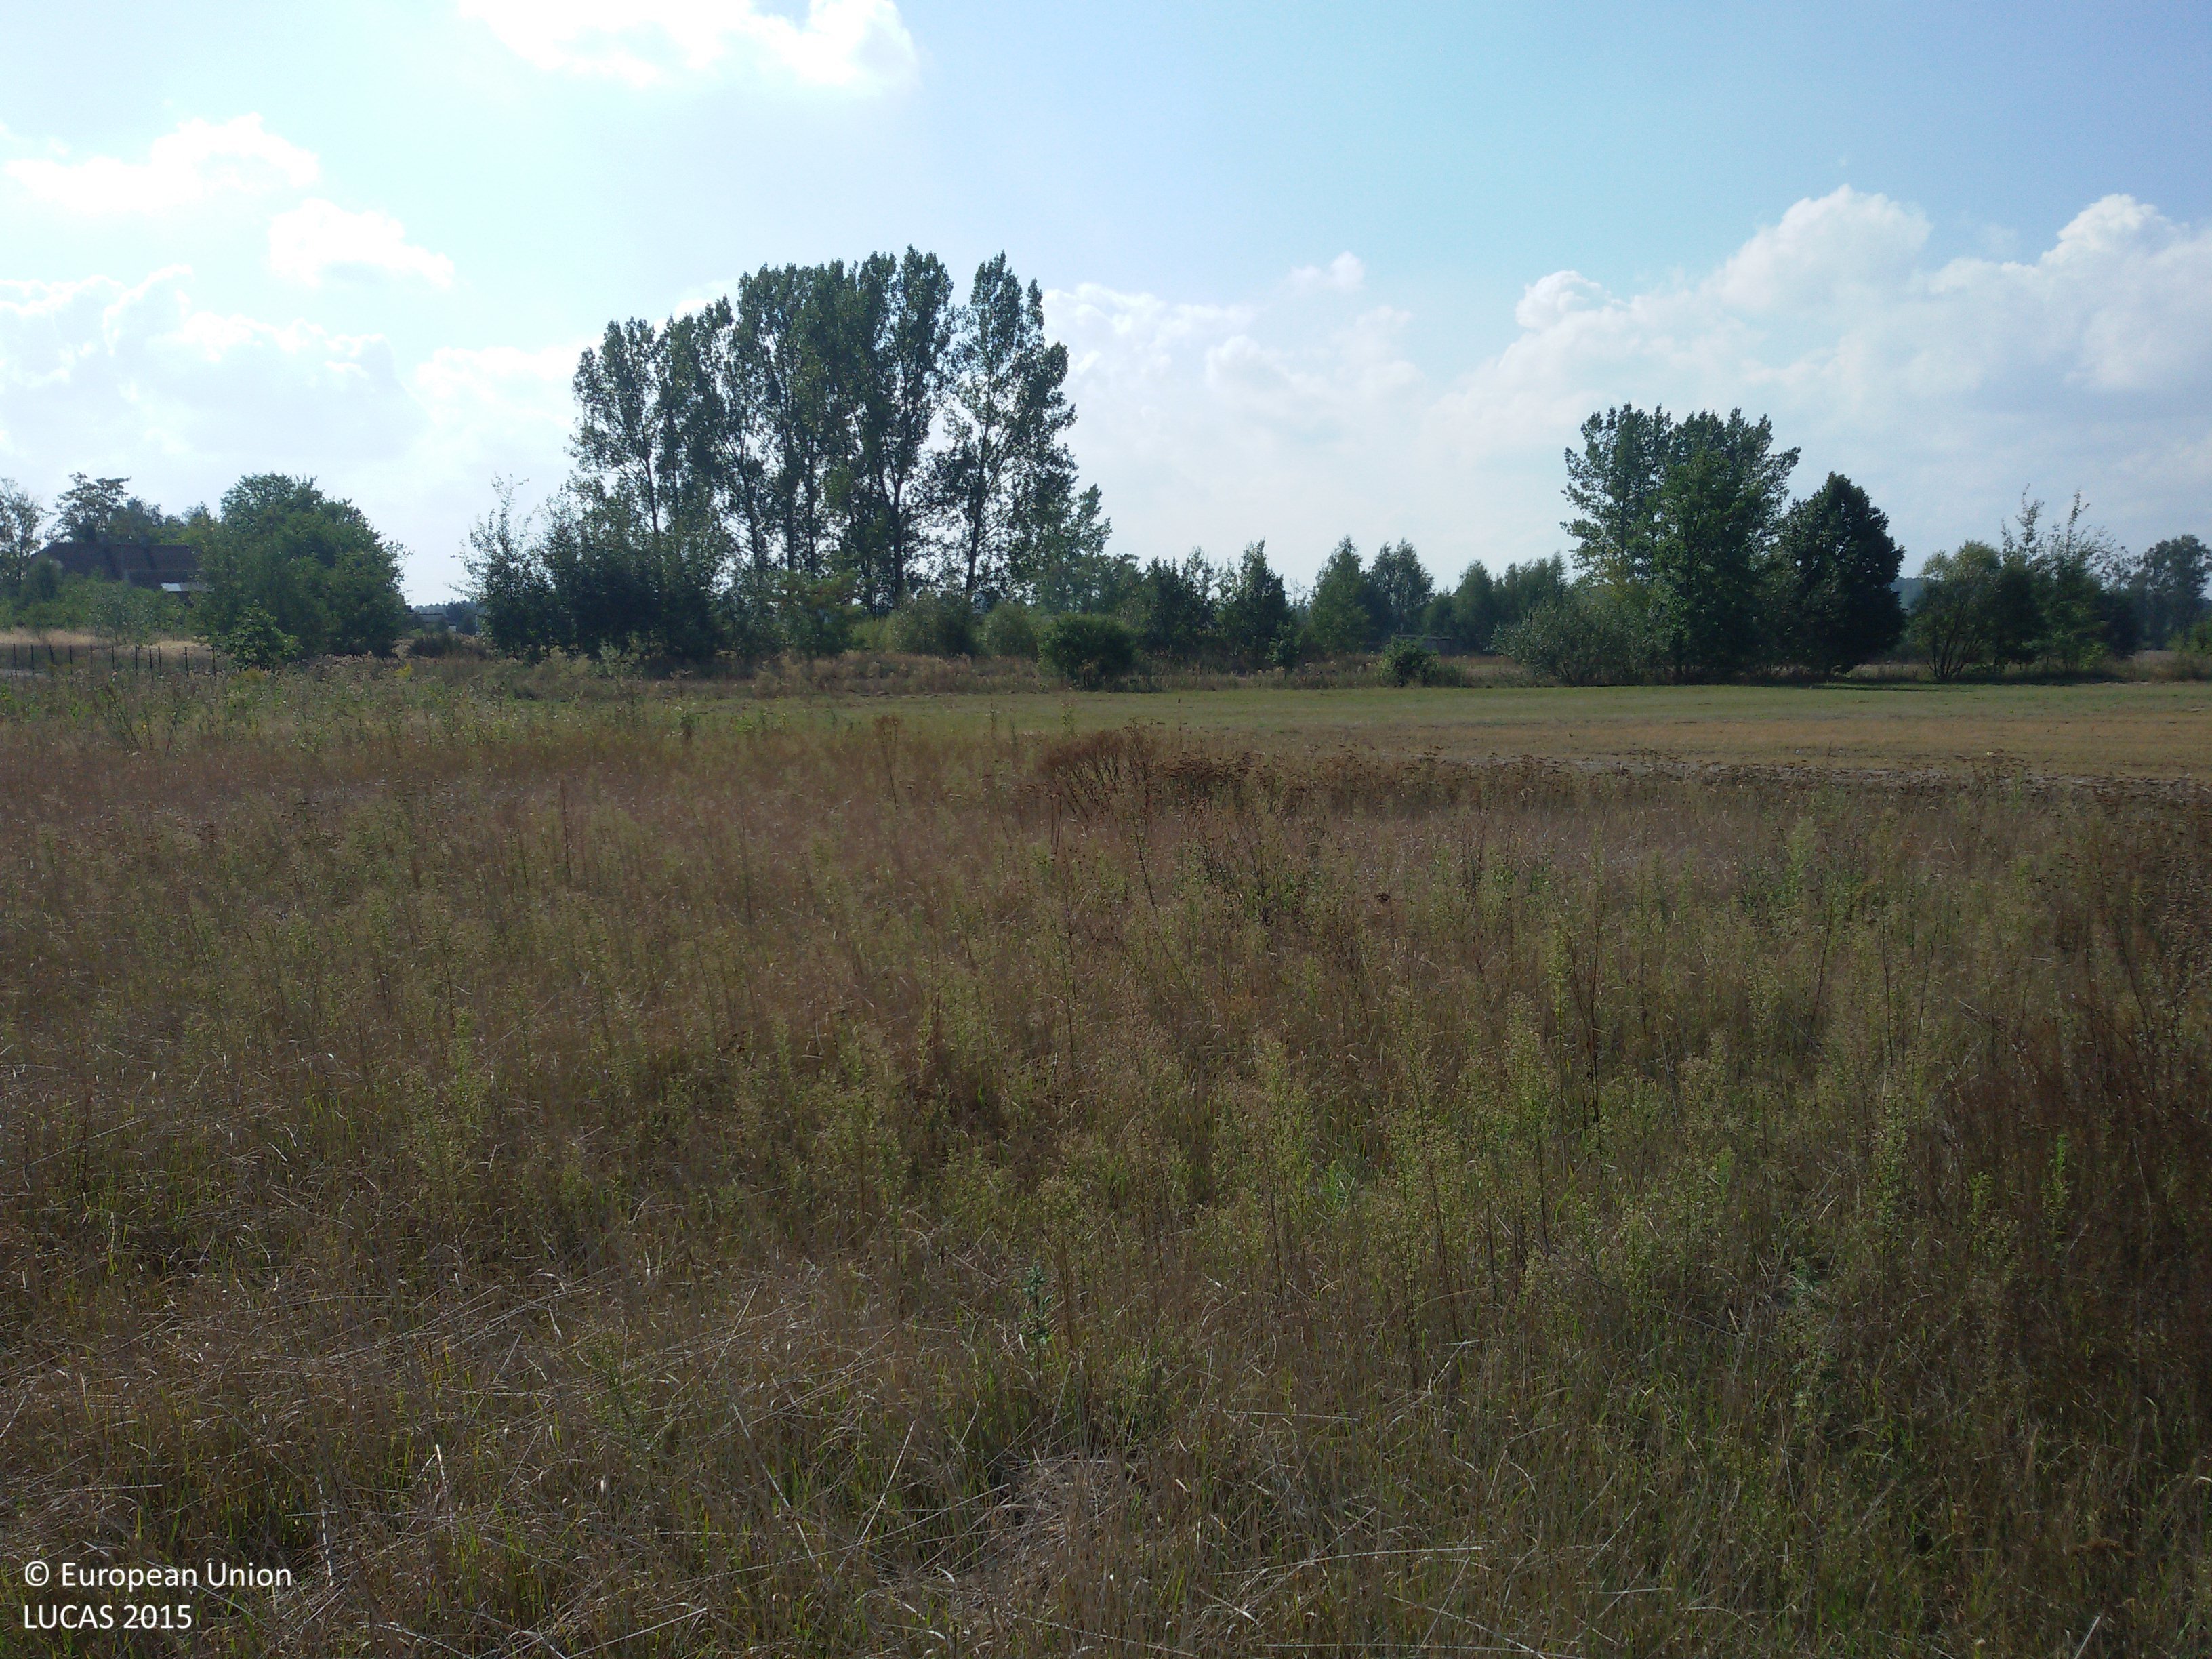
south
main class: Grassland
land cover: Spontaneously vegetated surfaces
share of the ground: > 75 %
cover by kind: herbaceous plants 100 %
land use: Semi-natural and natural areas not in use
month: September
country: PL
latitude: 51.4123
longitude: 18.8646
